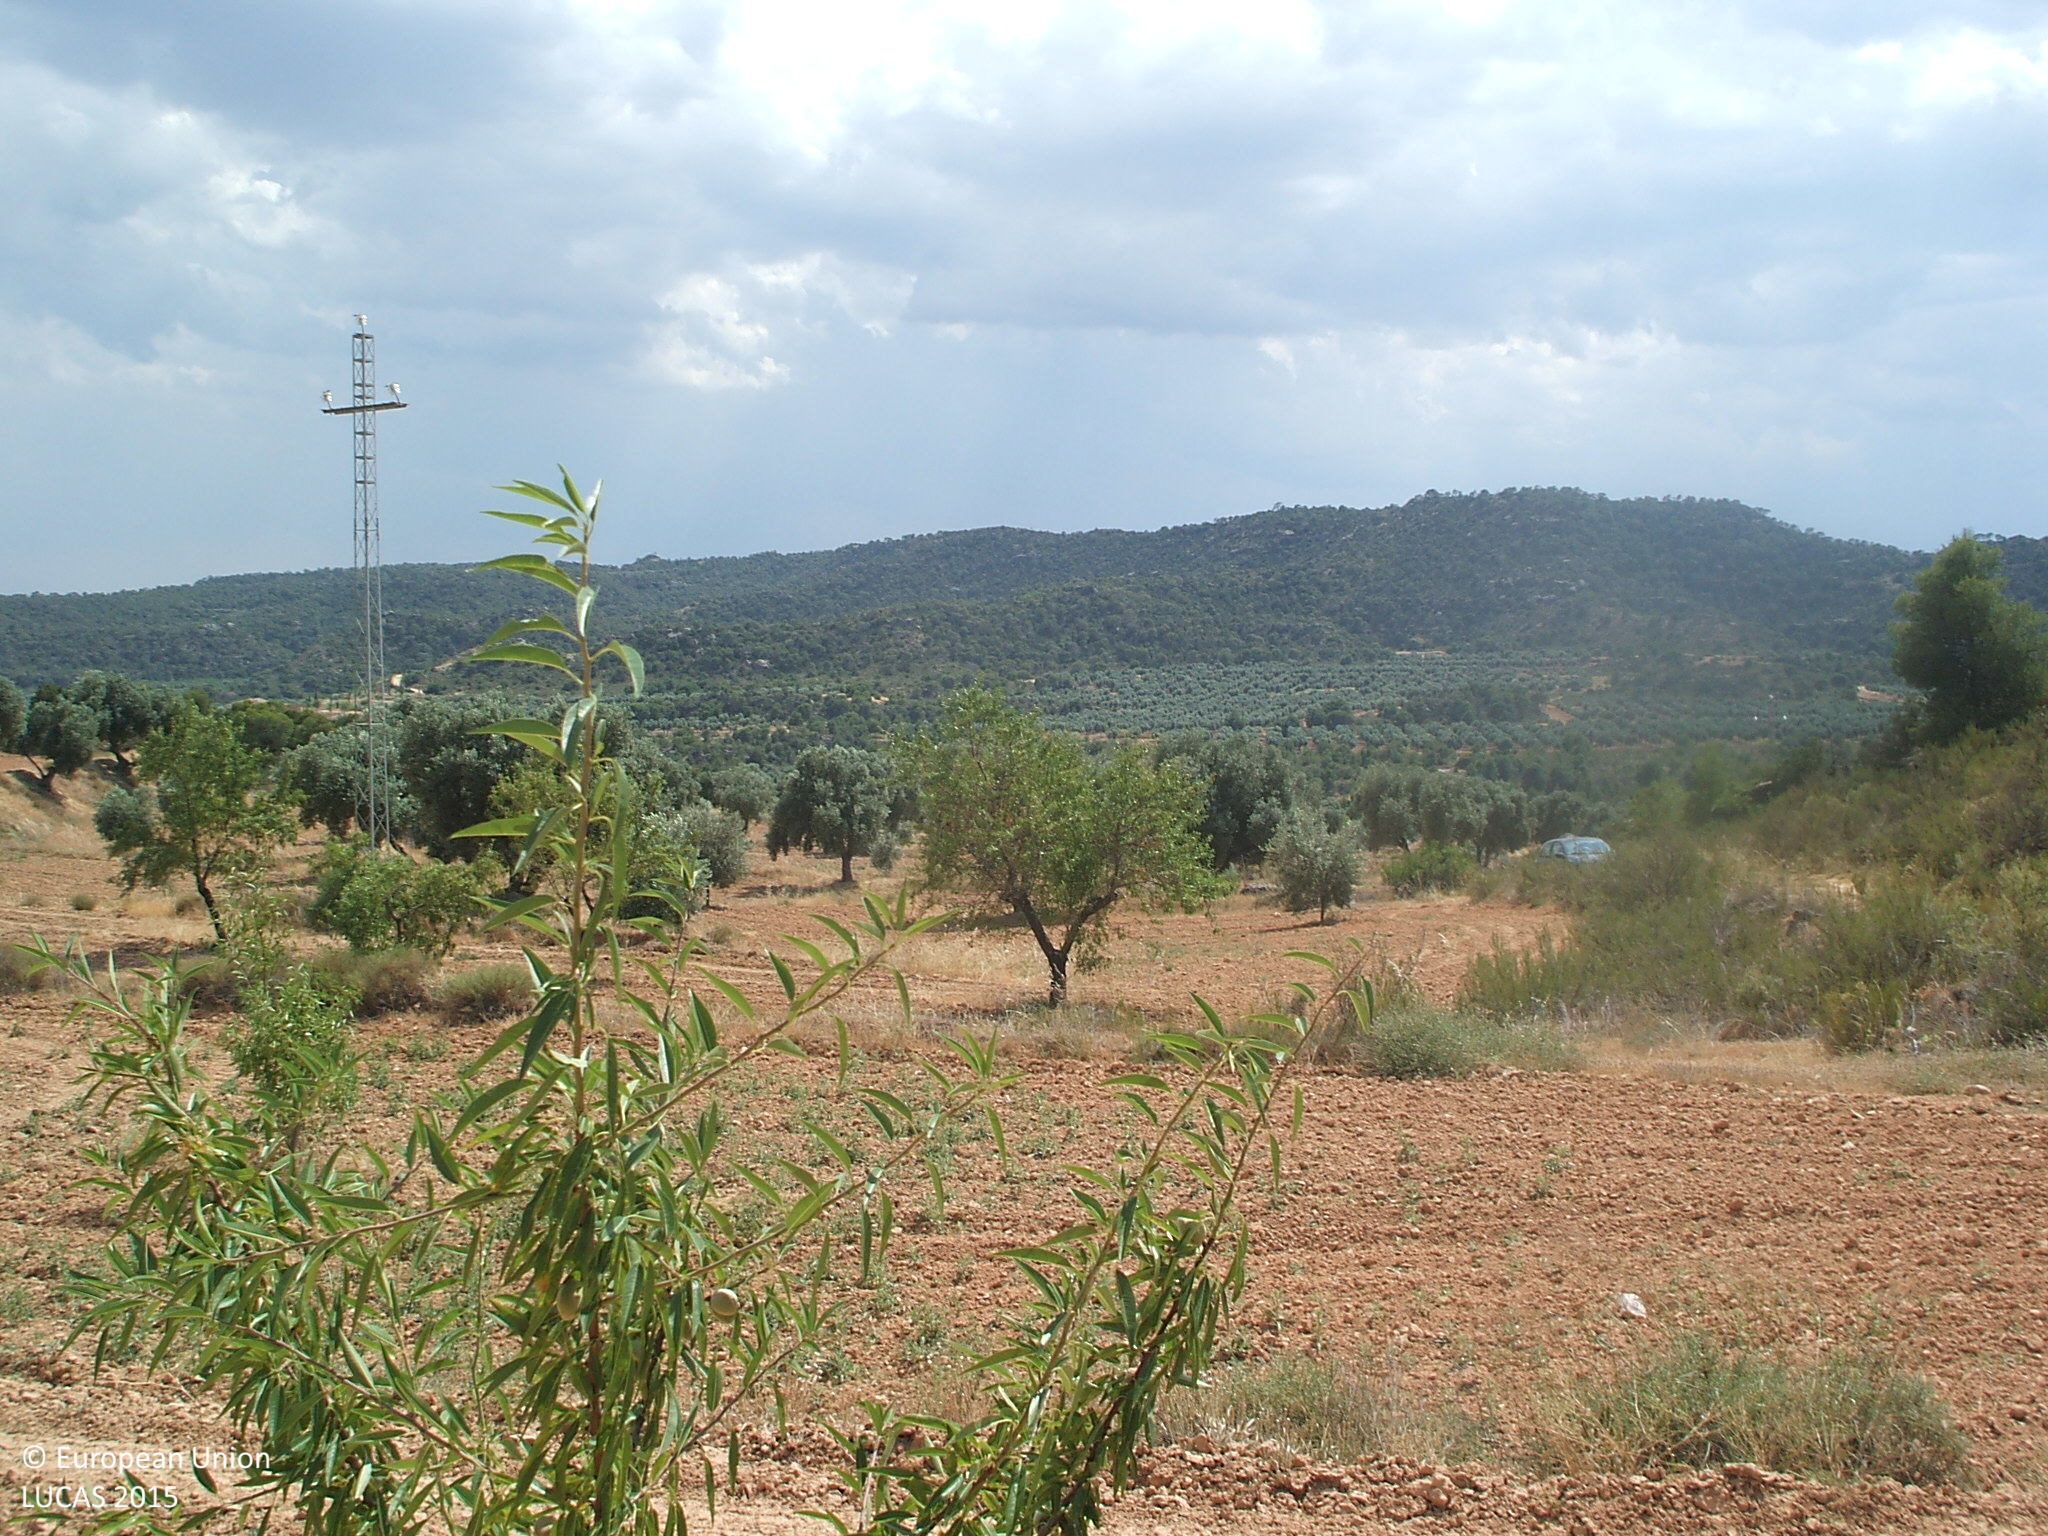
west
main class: Cropland
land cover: Nuts trees
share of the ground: < 10 %
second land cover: Other bare soil
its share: > 75 %
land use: Agriculture (excluding fallow land and kitchen gardens)
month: June
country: ES
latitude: 41.1003
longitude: -0.0247
